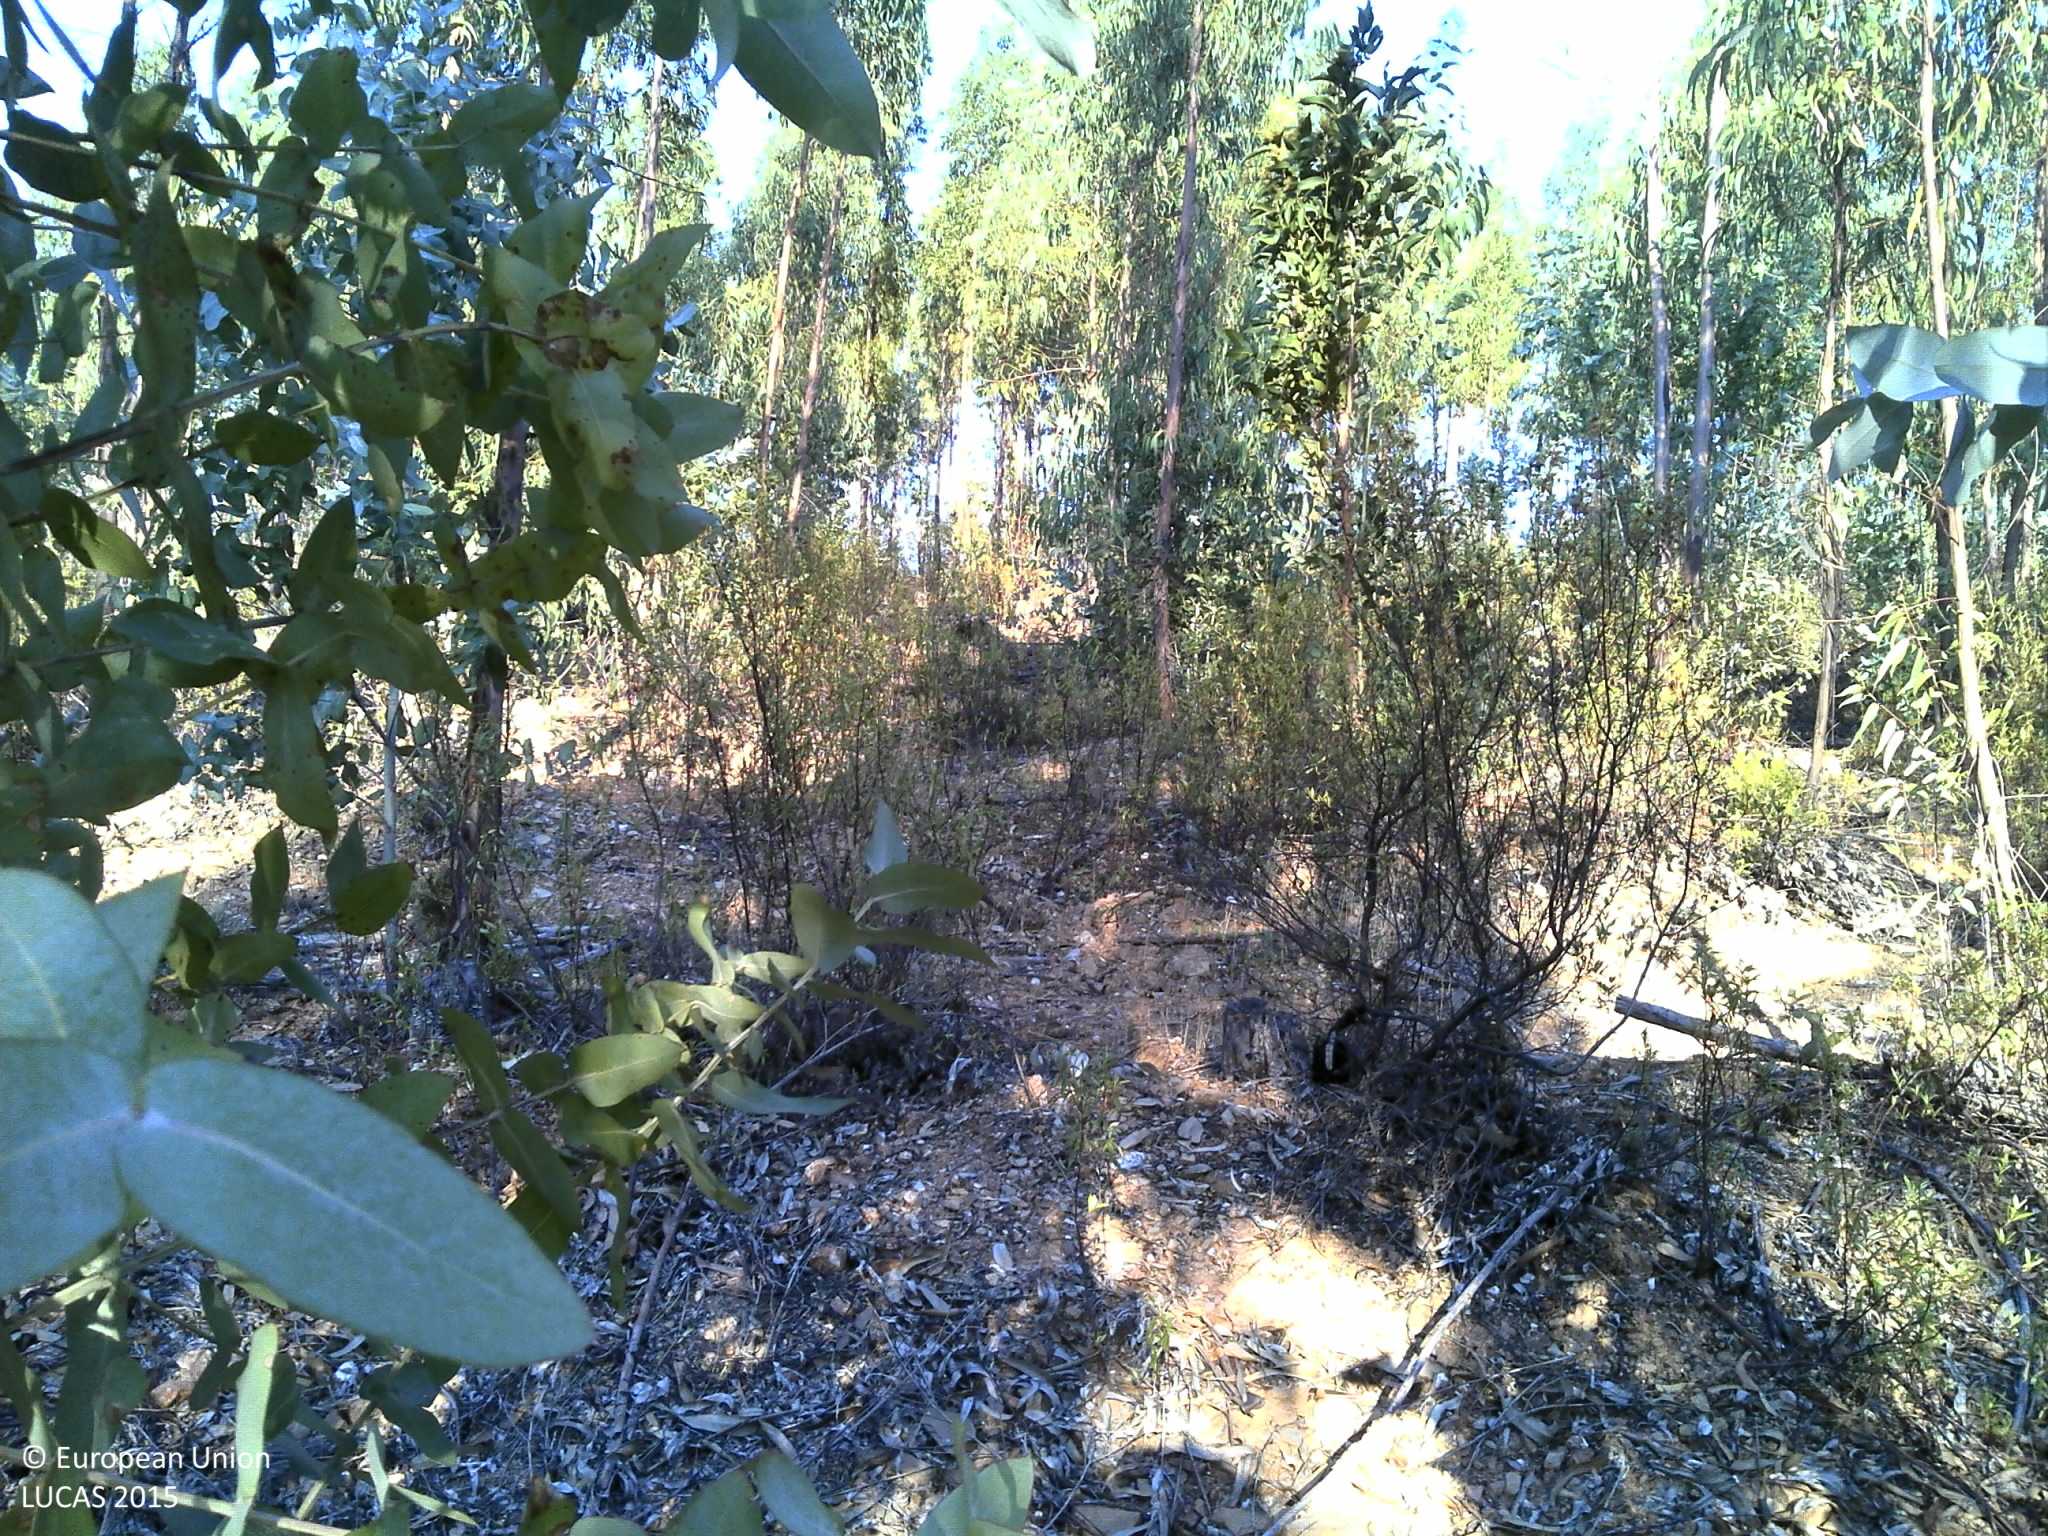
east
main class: Woodland
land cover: Broadleaved woodland
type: exotic forest
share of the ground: > 75 %
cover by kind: broadleaved forest trees 75 %, shrubs 25 %
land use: Forestry
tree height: > 5 m
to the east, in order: Broadleaved woodland; Tracks; Broadleaved woodland; Tracks; Broadleaved woodland; Tracks; Broadleaved woodland
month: August
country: PT
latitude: 39.6127
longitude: -7.6523
